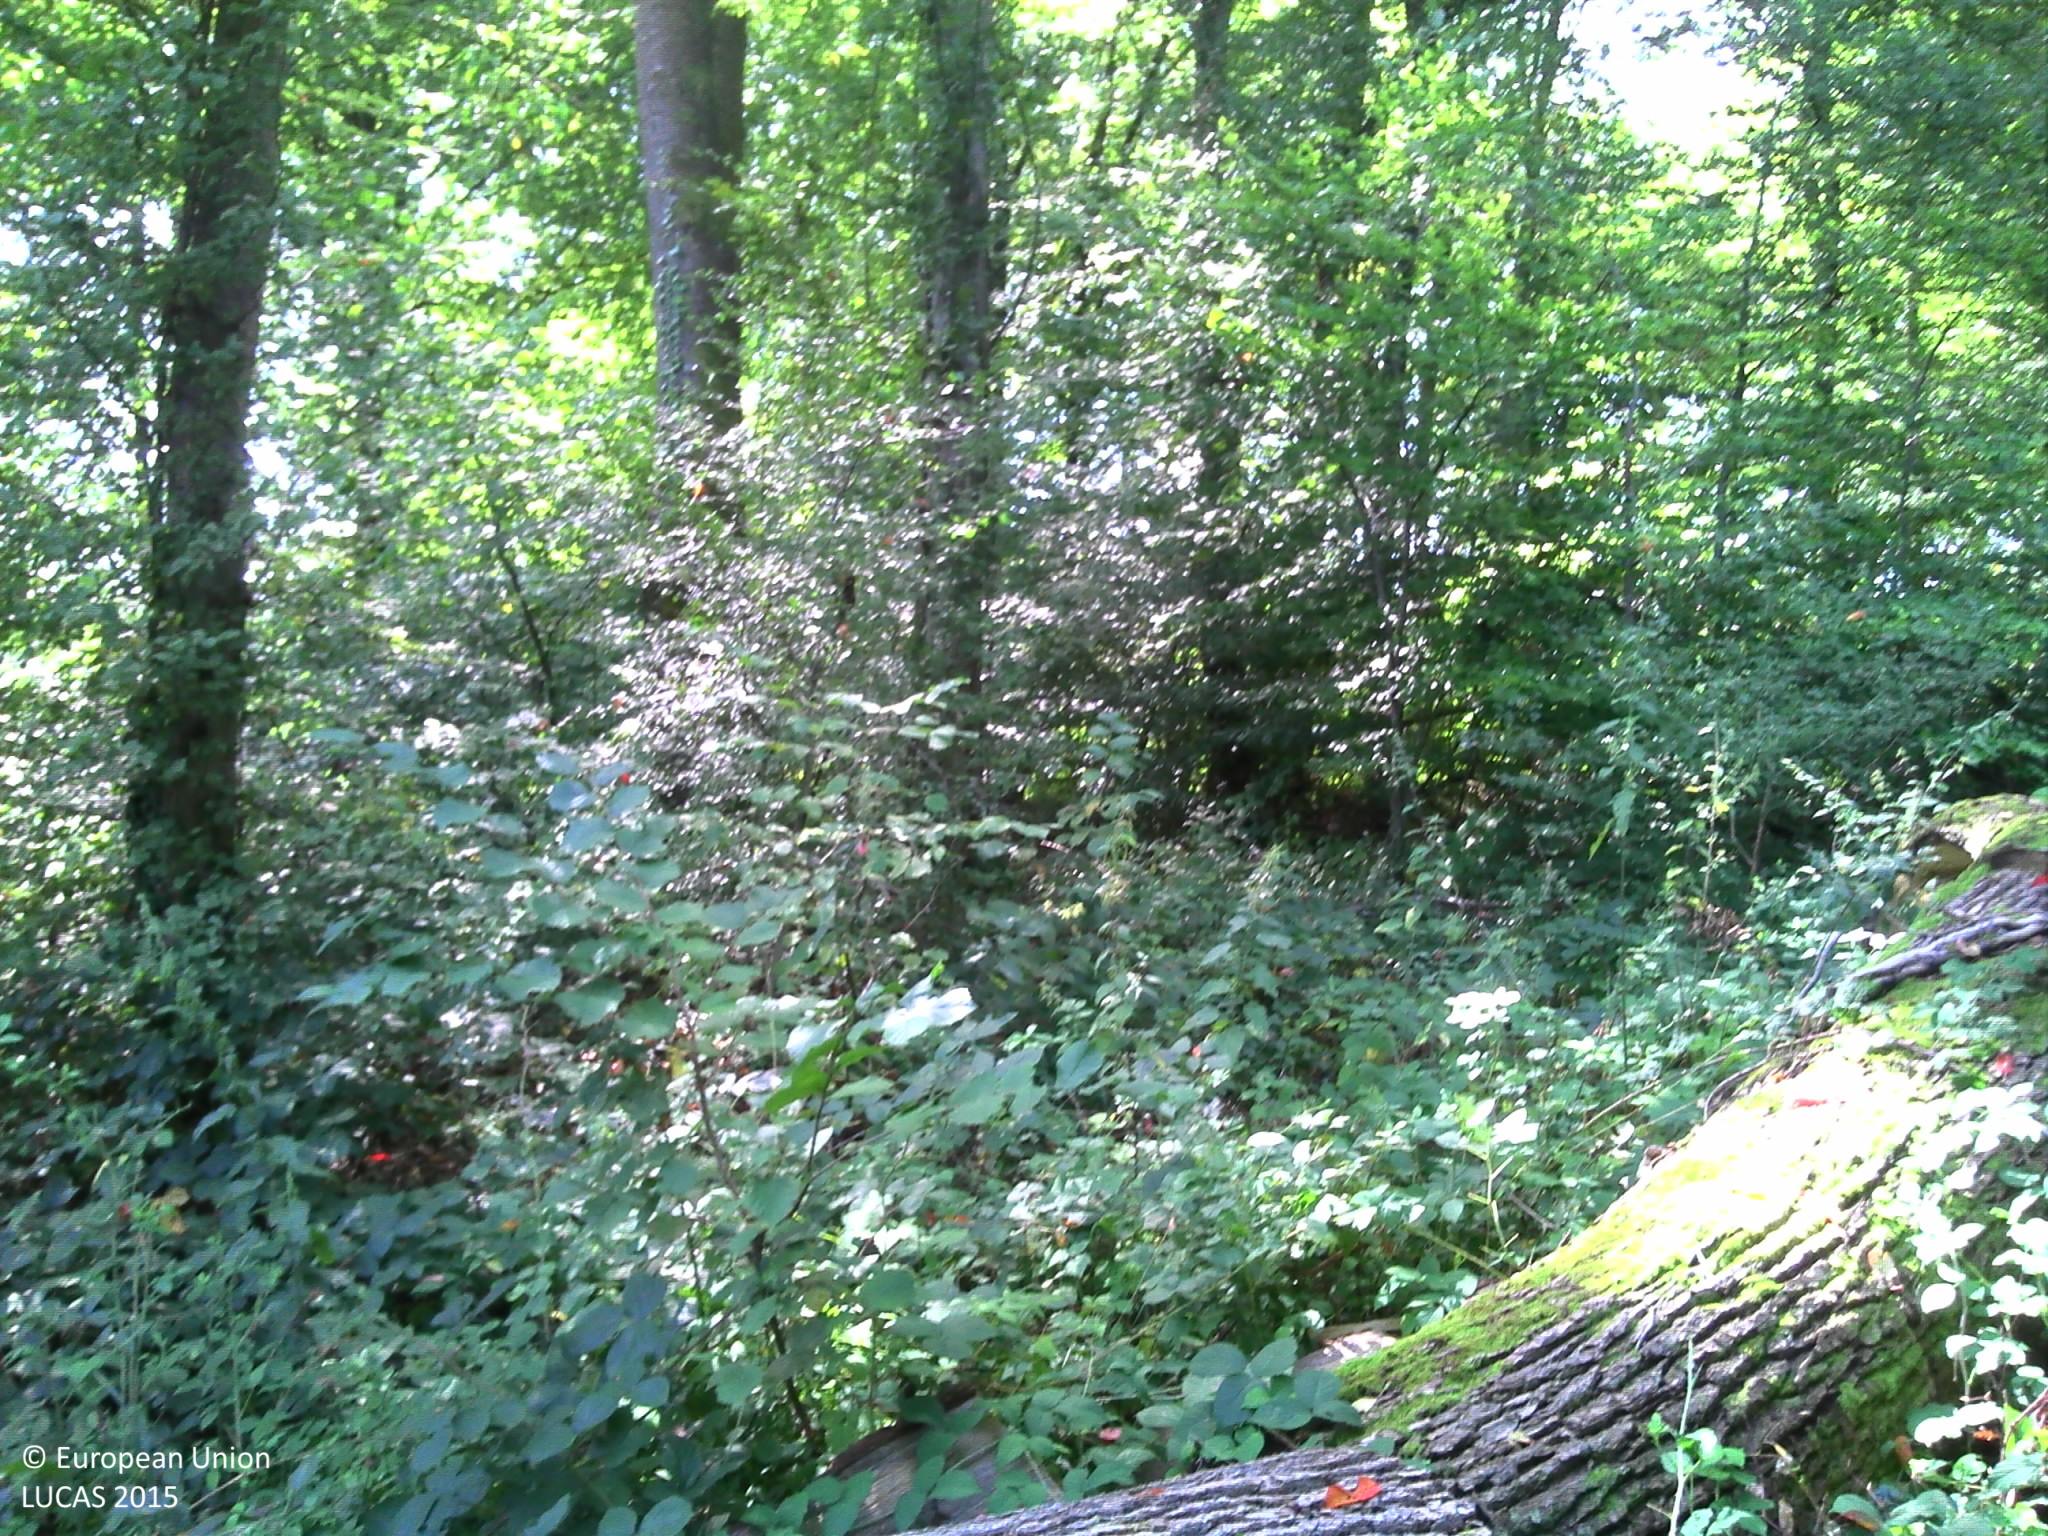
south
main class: Woodland
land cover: Broadleaved woodland
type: mesophytic deciduous forest
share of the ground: > 75 %
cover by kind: broadleaved forest trees 80 %, shrubs 20 %
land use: Forestry
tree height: > 5 m
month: August
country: FR
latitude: 47.6569
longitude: 6.8725
